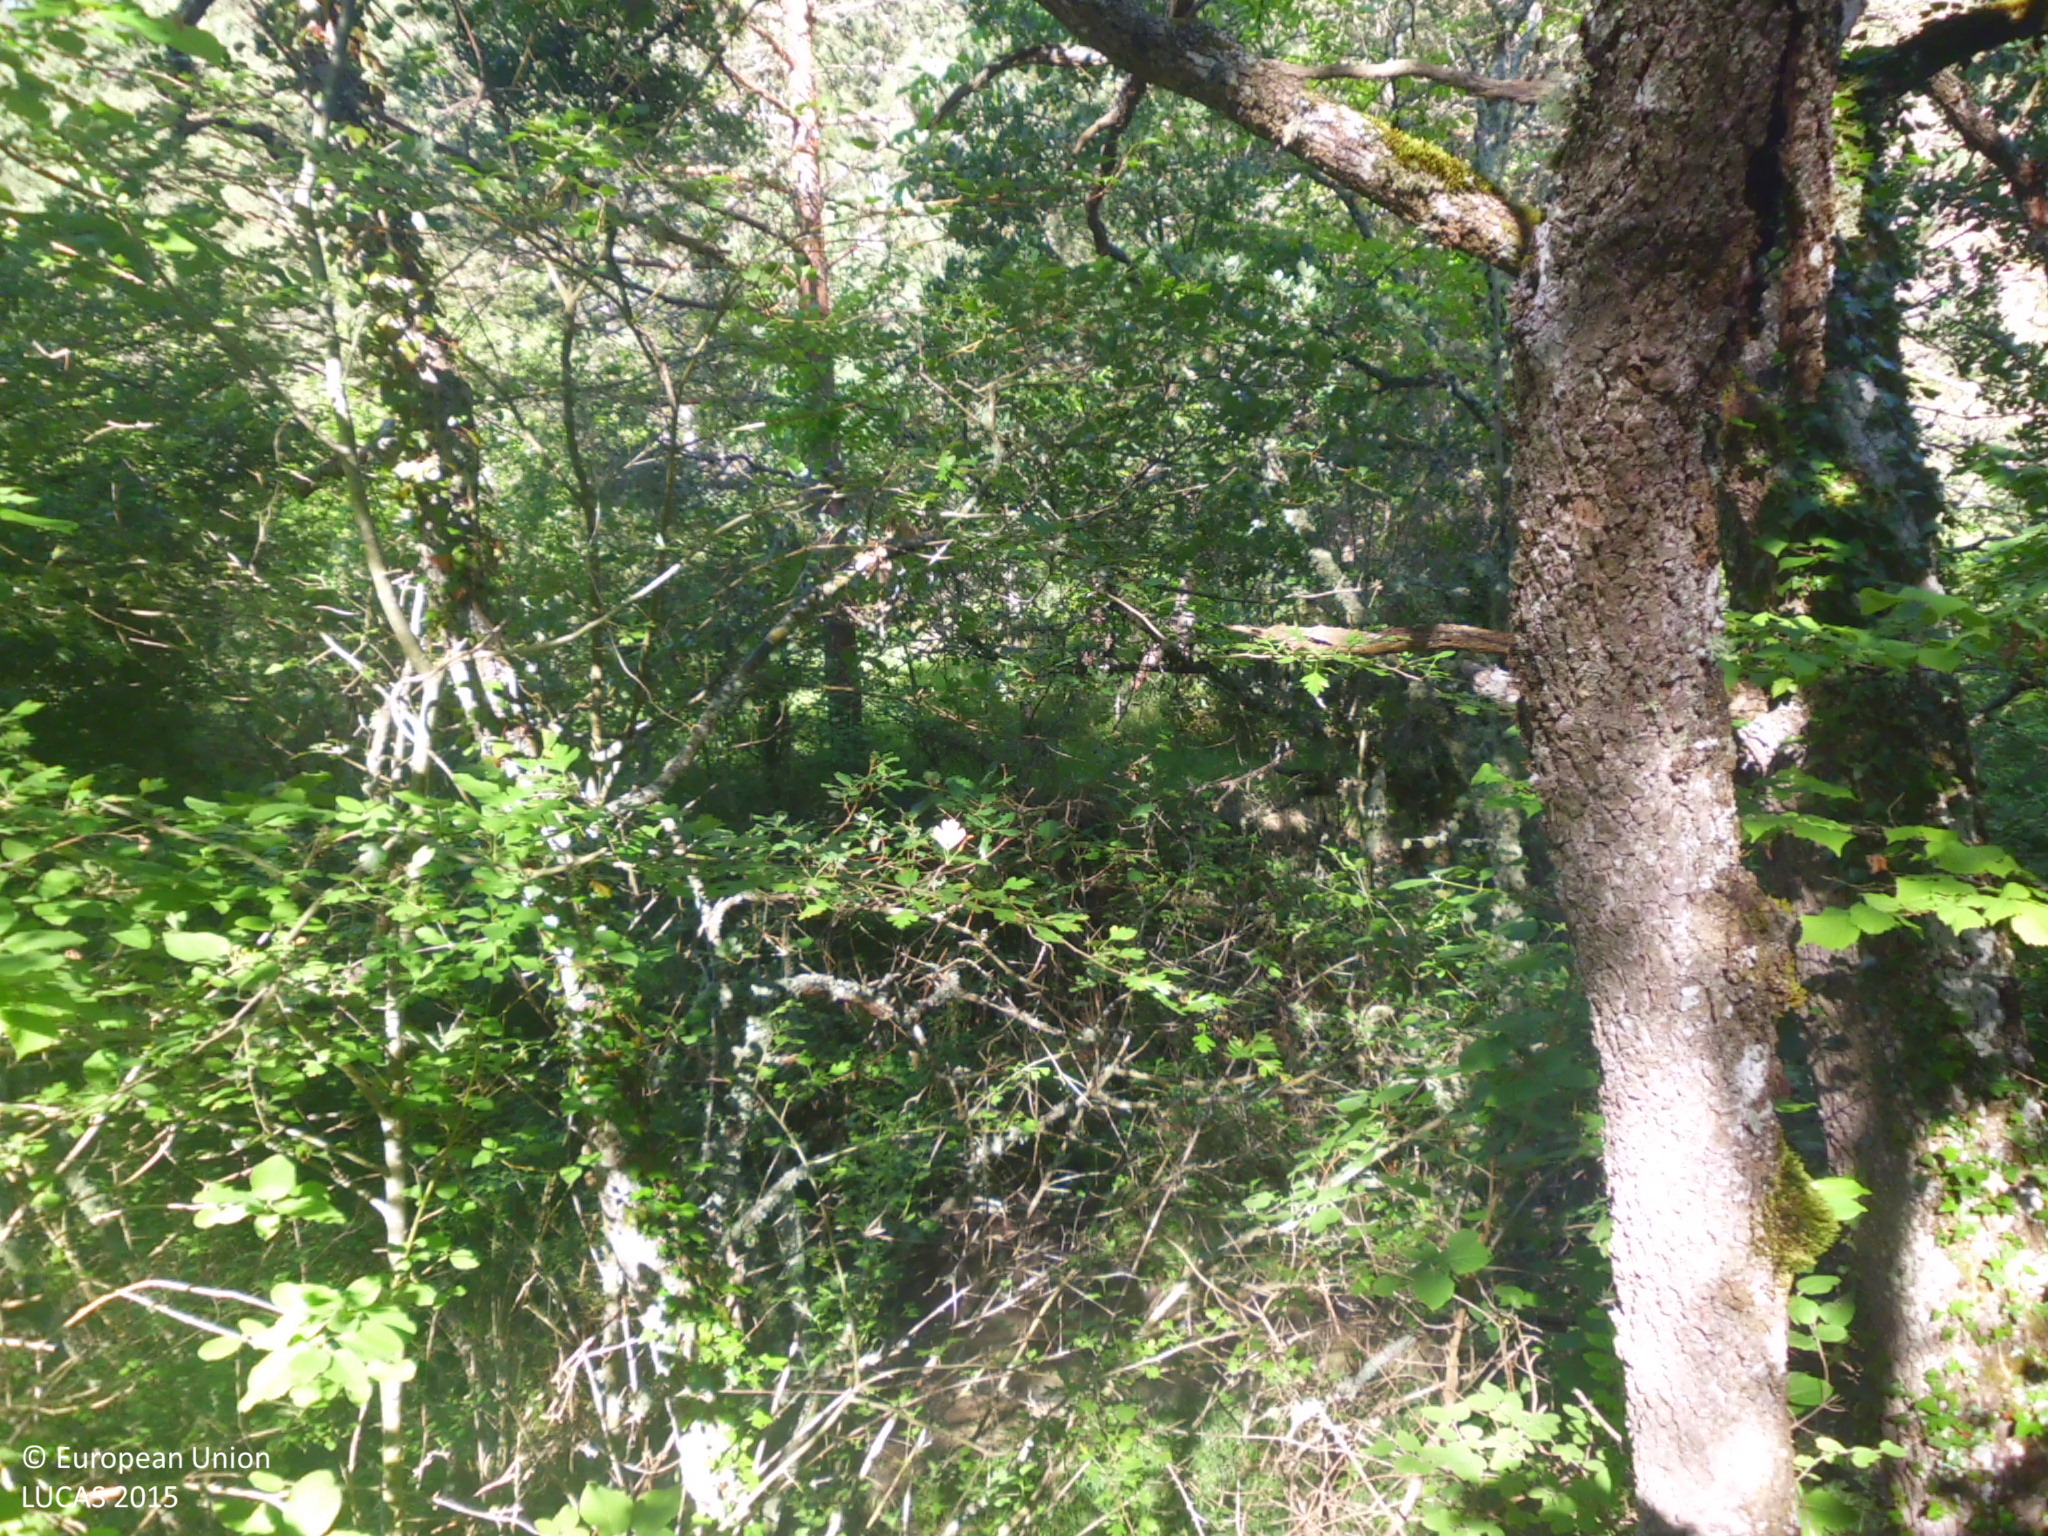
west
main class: Woodland
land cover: Pine dominated mixed woodland
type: coniferous forest of the mediterranean region
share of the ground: 50 - 75 %
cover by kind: coniferous forest trees 40 %, broadleaved forest trees 25 %, herbaceous plants 20 %, shrubs 15 %
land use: Forestry
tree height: > 5 m
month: June
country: ES
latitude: 42.8991
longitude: -3.3488
